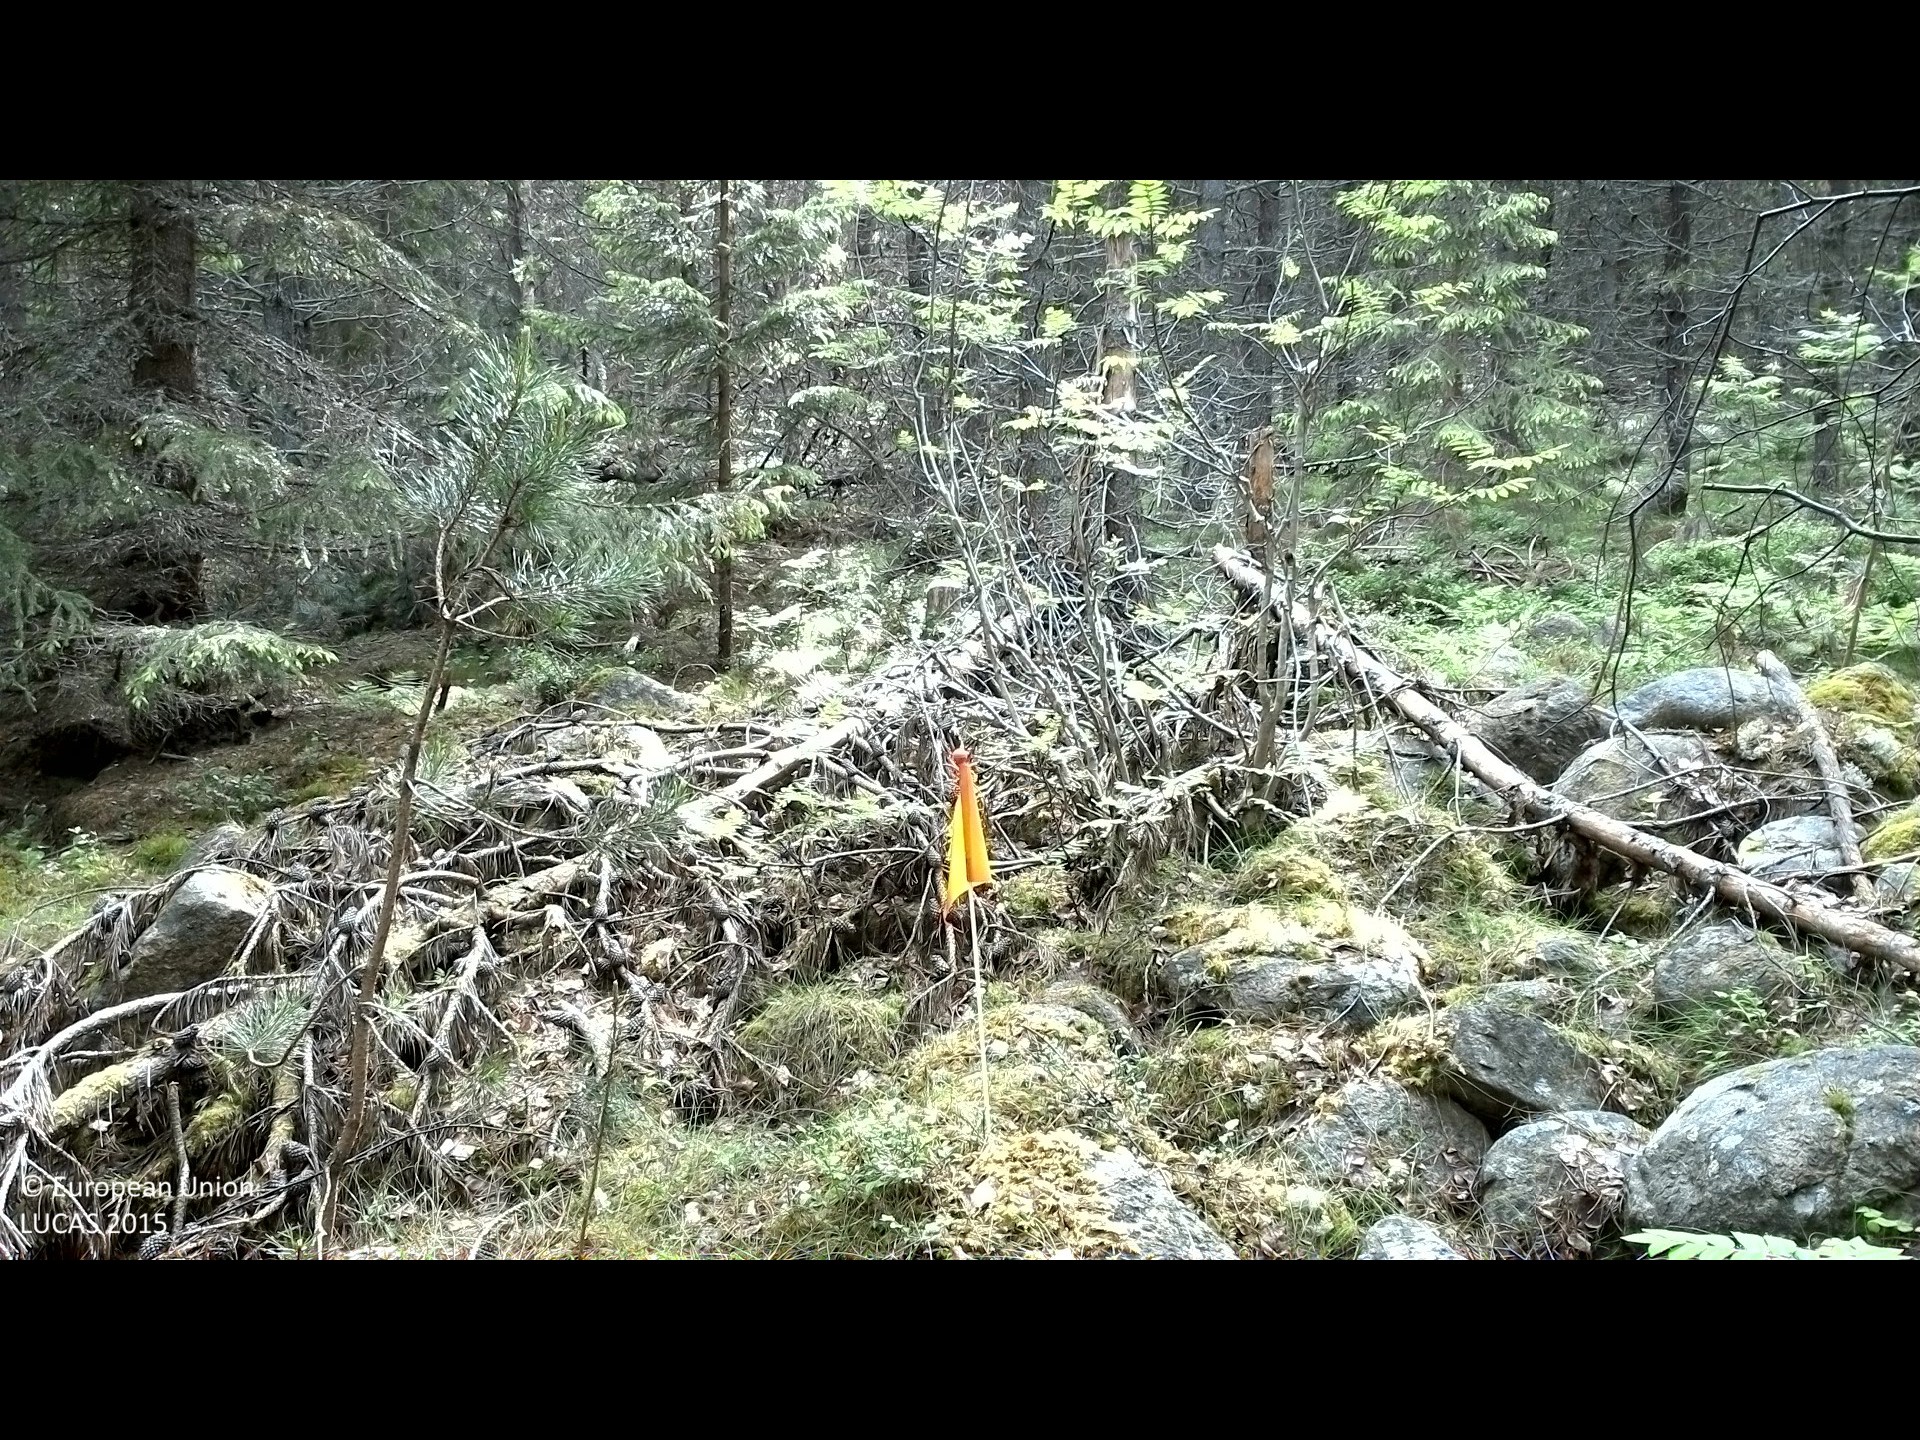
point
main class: Woodland
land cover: Pine dominated coniferous woodland
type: exotic forest
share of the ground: 50 - 75 %
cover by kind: coniferous forest trees 60 %, shrubs 15 %, herbaceous plants 15 %, broadleaved forest trees 5 %, lichens and mosses 5 %
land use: Forestry
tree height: > 5 m
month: June
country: SE
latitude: 62.0438
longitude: 16.7697
